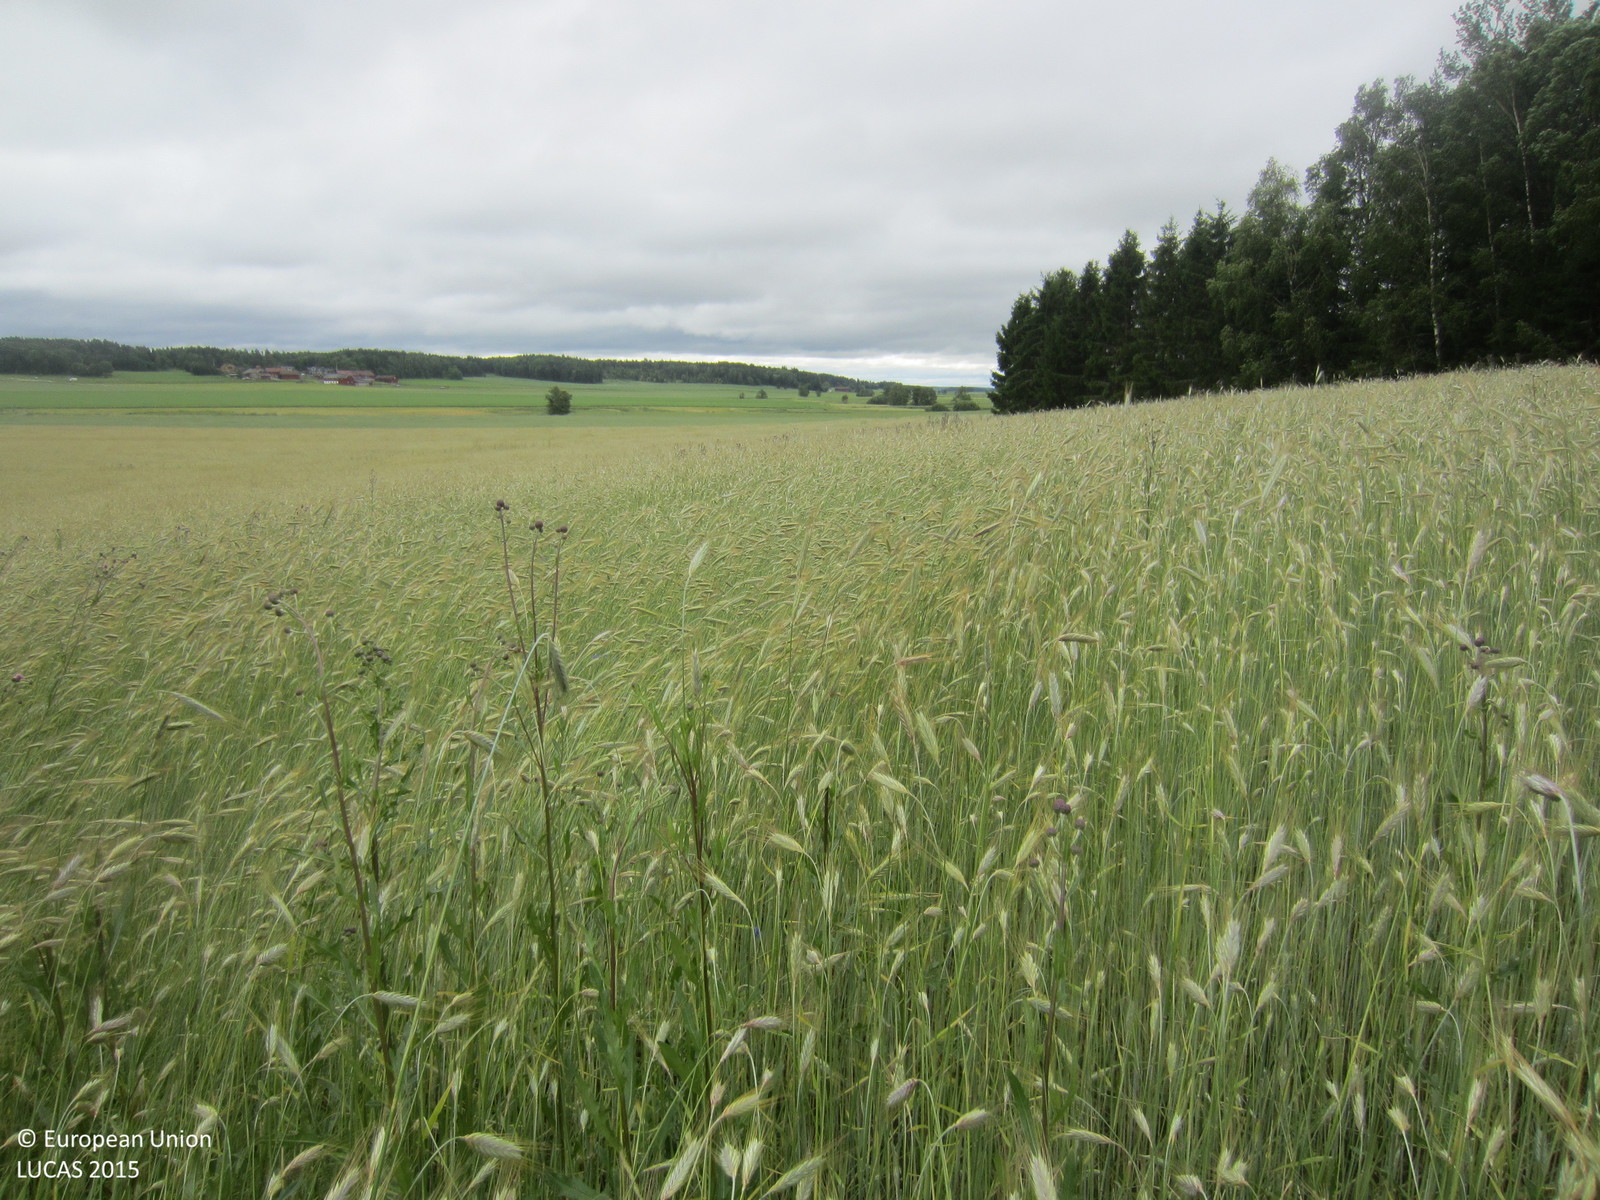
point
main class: Cropland
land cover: Rye
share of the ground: > 75 %
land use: Agriculture (excluding fallow land and kitchen gardens)
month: July
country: SE
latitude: 59.7884
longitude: 17.0302
